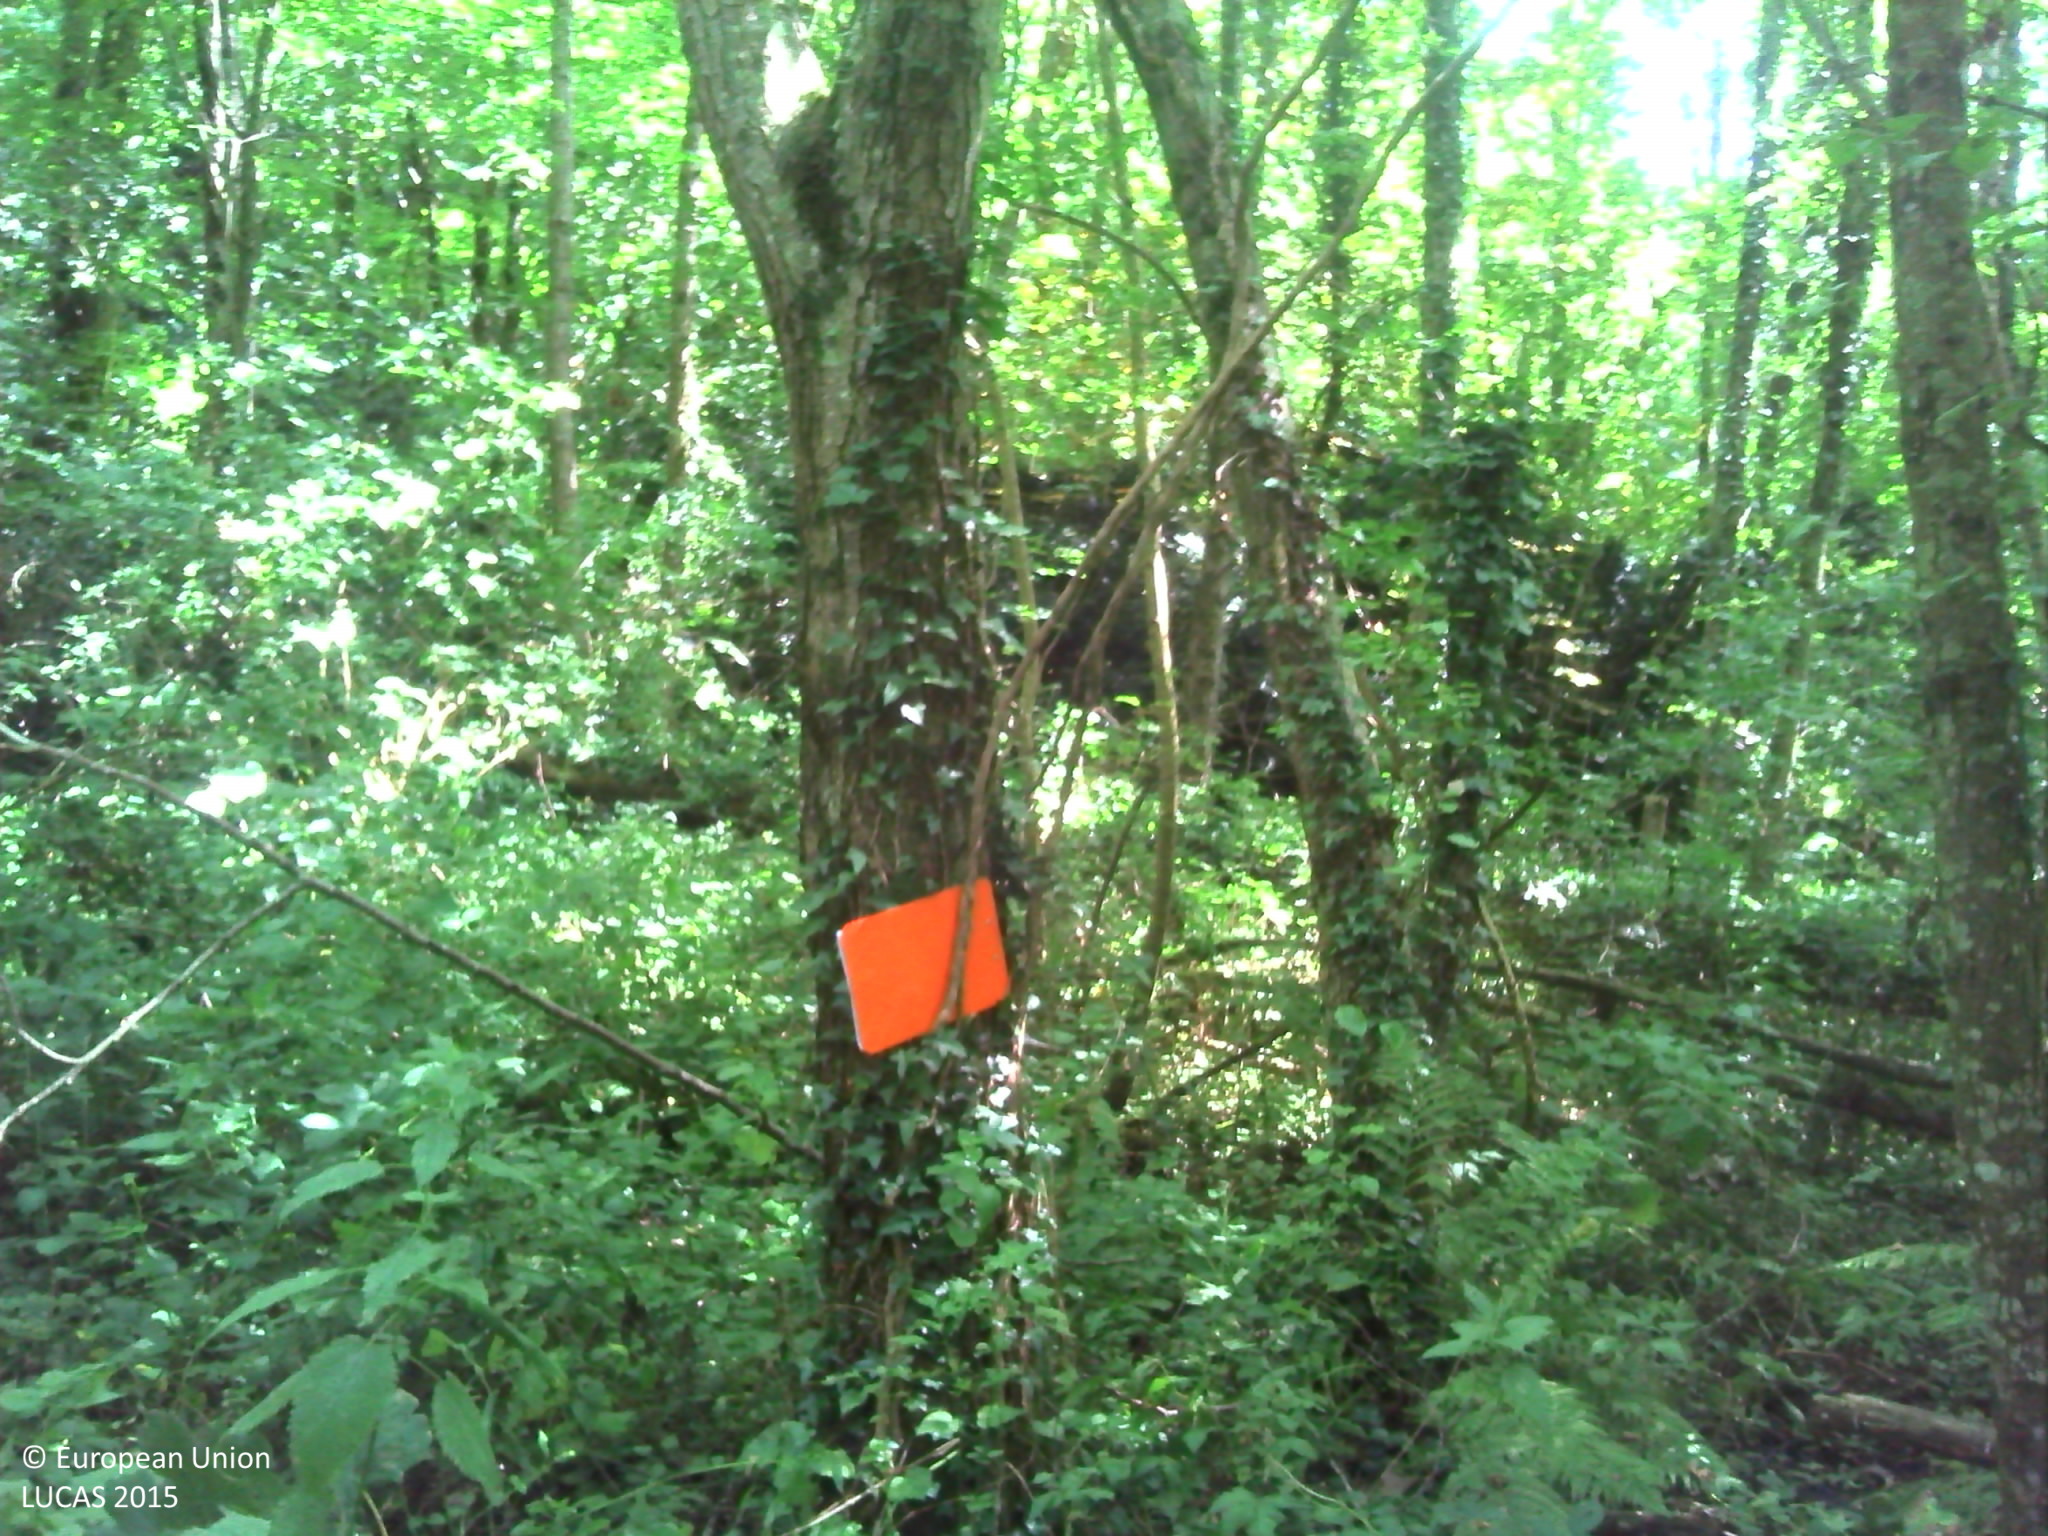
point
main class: Woodland
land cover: Broadleaved woodland
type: exotic forest
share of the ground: > 75 %
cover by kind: broadleaved forest trees 95 %, shrubs 5 %
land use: Agriculture (excluding fallow land and kitchen gardens)
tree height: > 5 m
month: August
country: FR
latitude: 46.7888
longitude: -1.1037
